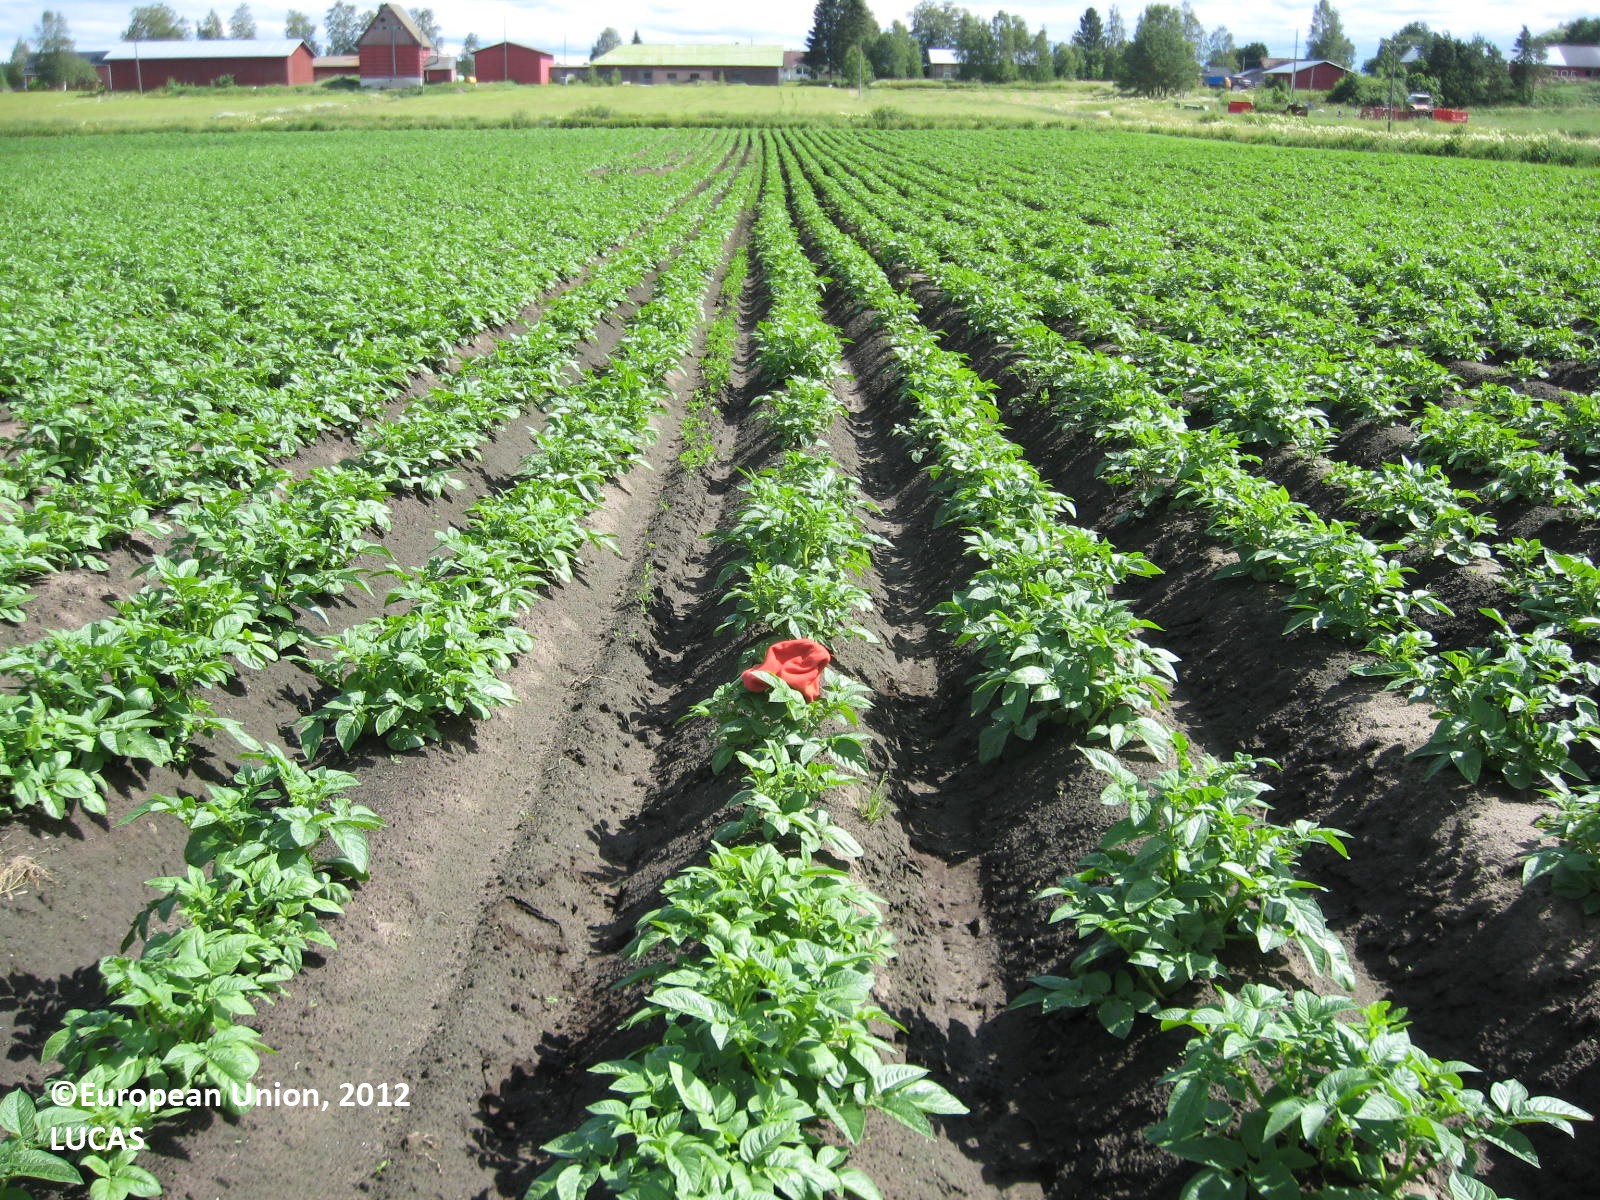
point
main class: Cropland
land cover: Potatoes
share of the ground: 50 - 75 %
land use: Agriculture (excluding fallow land and kitchen gardens)
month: July
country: FI
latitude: 62.3854
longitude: 21.5511
